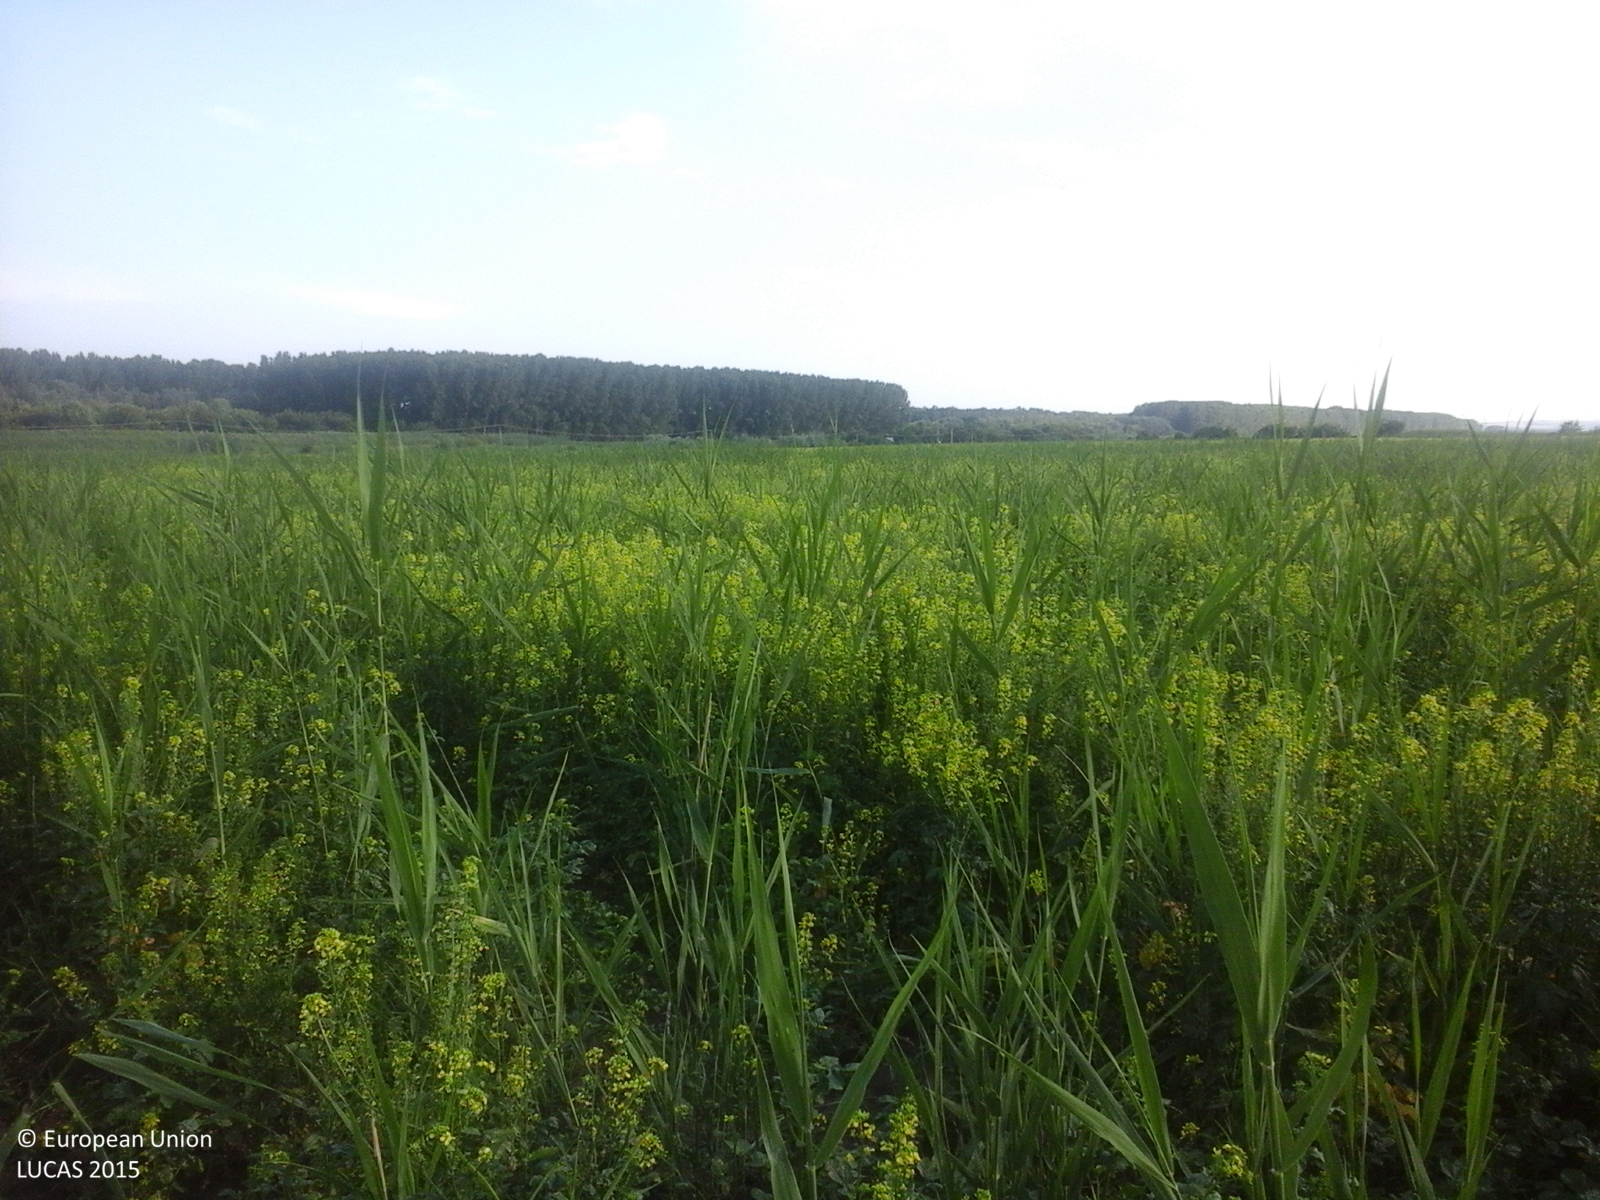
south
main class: Cropland
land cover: Other fibre and oleaginous crops
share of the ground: > 75 %
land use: Agriculture (excluding fallow land and kitchen gardens)
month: July
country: RO
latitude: 43.7546
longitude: 25.8020
